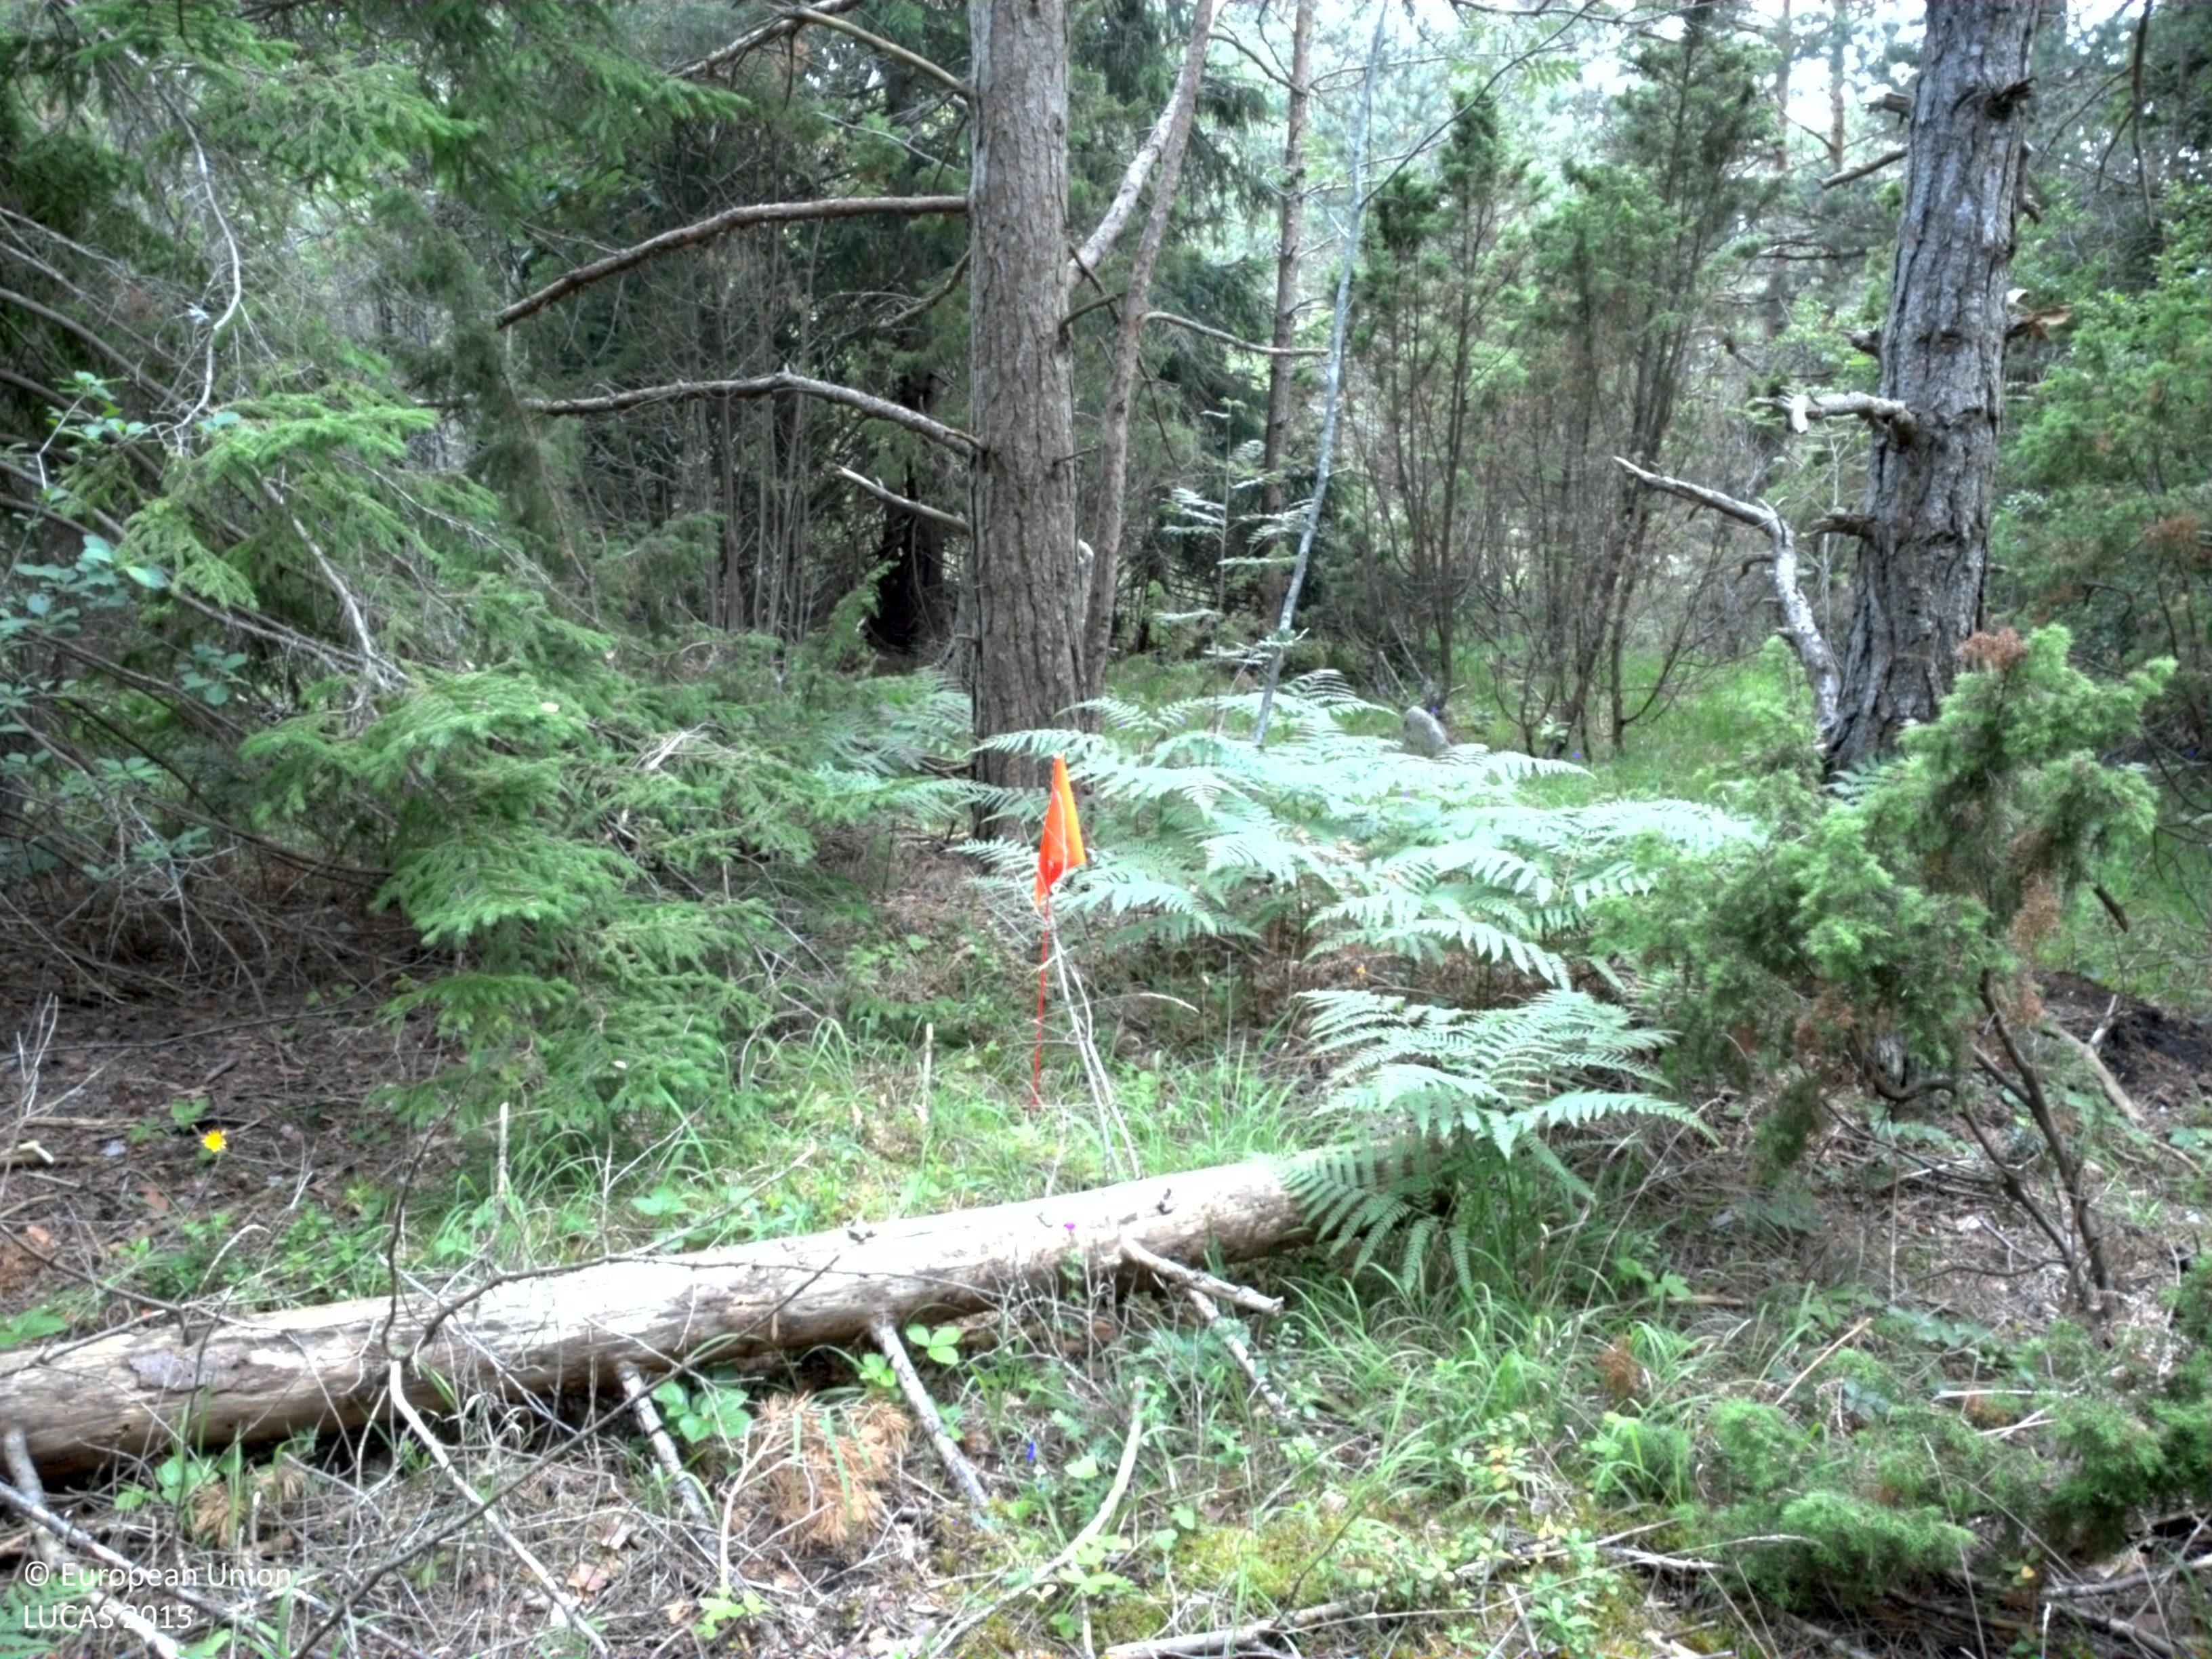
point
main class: Woodland
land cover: Pine dominated coniferous woodland
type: hemiboreal forest and nemoral coniferous forest and mixed broadleaved-coniferous forest
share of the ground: > 75 %
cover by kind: coniferous forest trees 70 %, herbaceous plants 15 %, shrubs 10 %, broadleaved forest trees 5 %
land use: Forestry
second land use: Amenities, museums, leisure
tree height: > 5 m
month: June
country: SE
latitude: 57.8744
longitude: 18.8274
